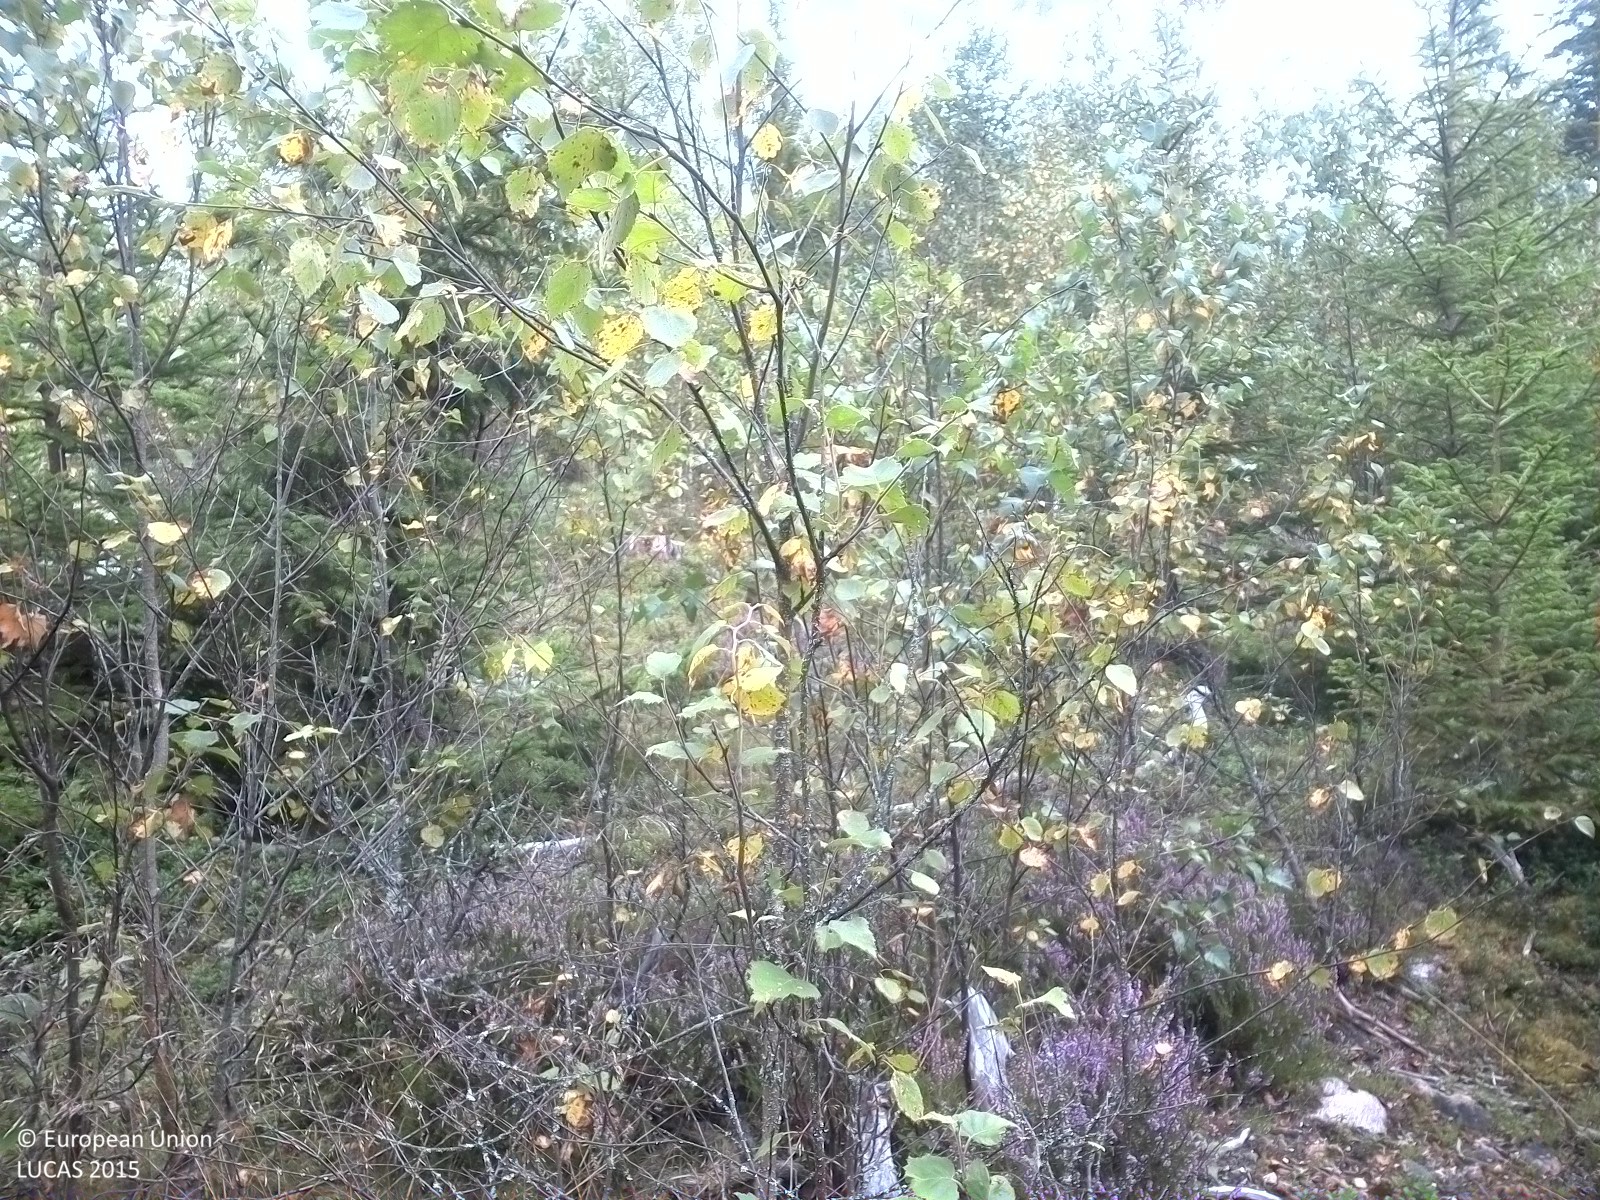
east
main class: Woodland
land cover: Spruce dominated mixed woodland
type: boreal forest
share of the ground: 50 - 75 %
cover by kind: coniferous forest trees 35 %, broadleaved forest trees 25 %, herbaceous plants 20 %, shrubs 10 %, lichens and mosses 10 %
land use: Forestry
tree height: < 5 m
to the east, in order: Spruce dominated mixed woodland; Other mixed woodland; Spruce dominated mixed woodland; Pine dominated coniferous woodland
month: August
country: SE
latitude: 59.3539
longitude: 15.8841
